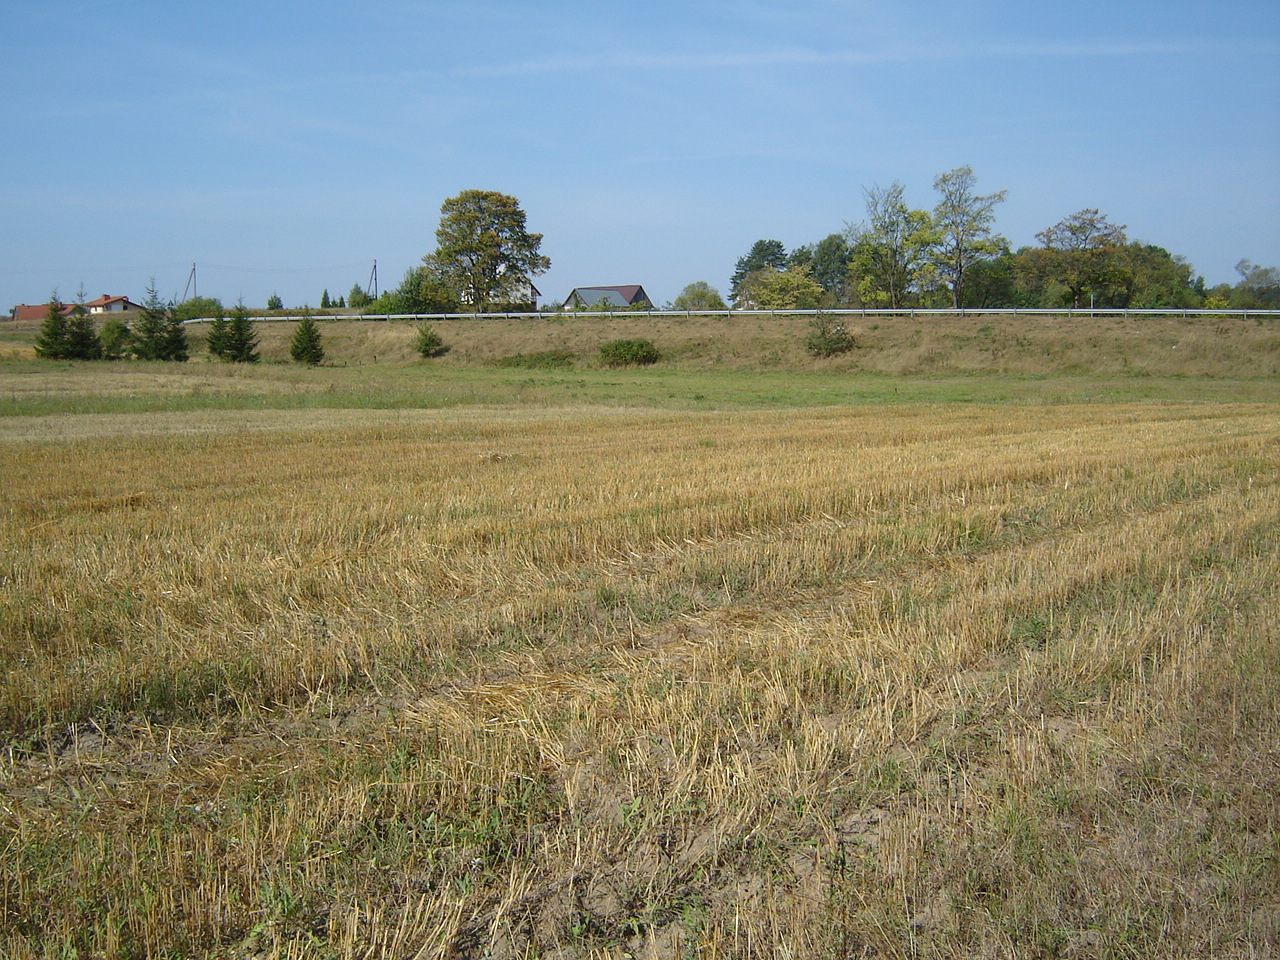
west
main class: Grassland
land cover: Grassland without tree/shrub cover
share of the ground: > 75 %
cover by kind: herbaceous plants 100 %
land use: Agriculture (excluding fallow land and kitchen gardens)
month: August
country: LT
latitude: 54.6147
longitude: 24.9001
